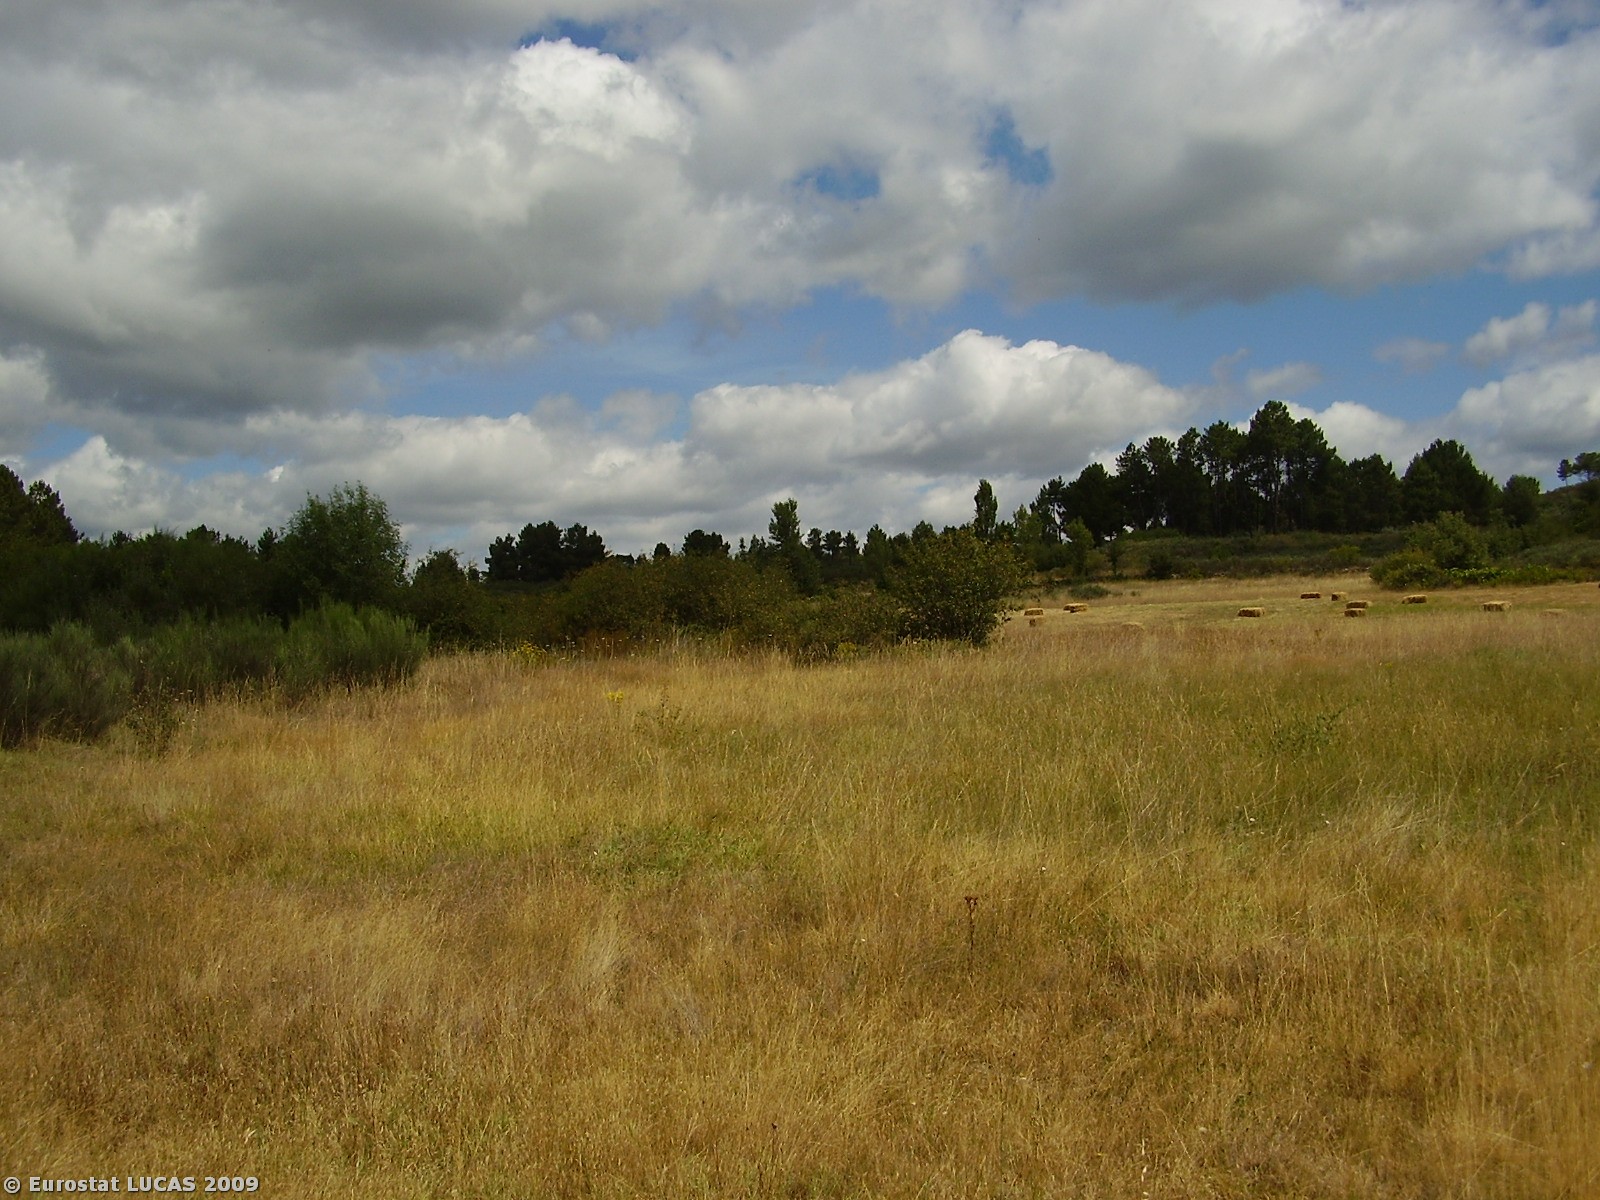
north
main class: Grassland
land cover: Spontaneously vegetated surfaces
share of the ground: > 75 %
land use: Fallow land
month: July
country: PT
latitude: 41.5636
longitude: -7.5775
